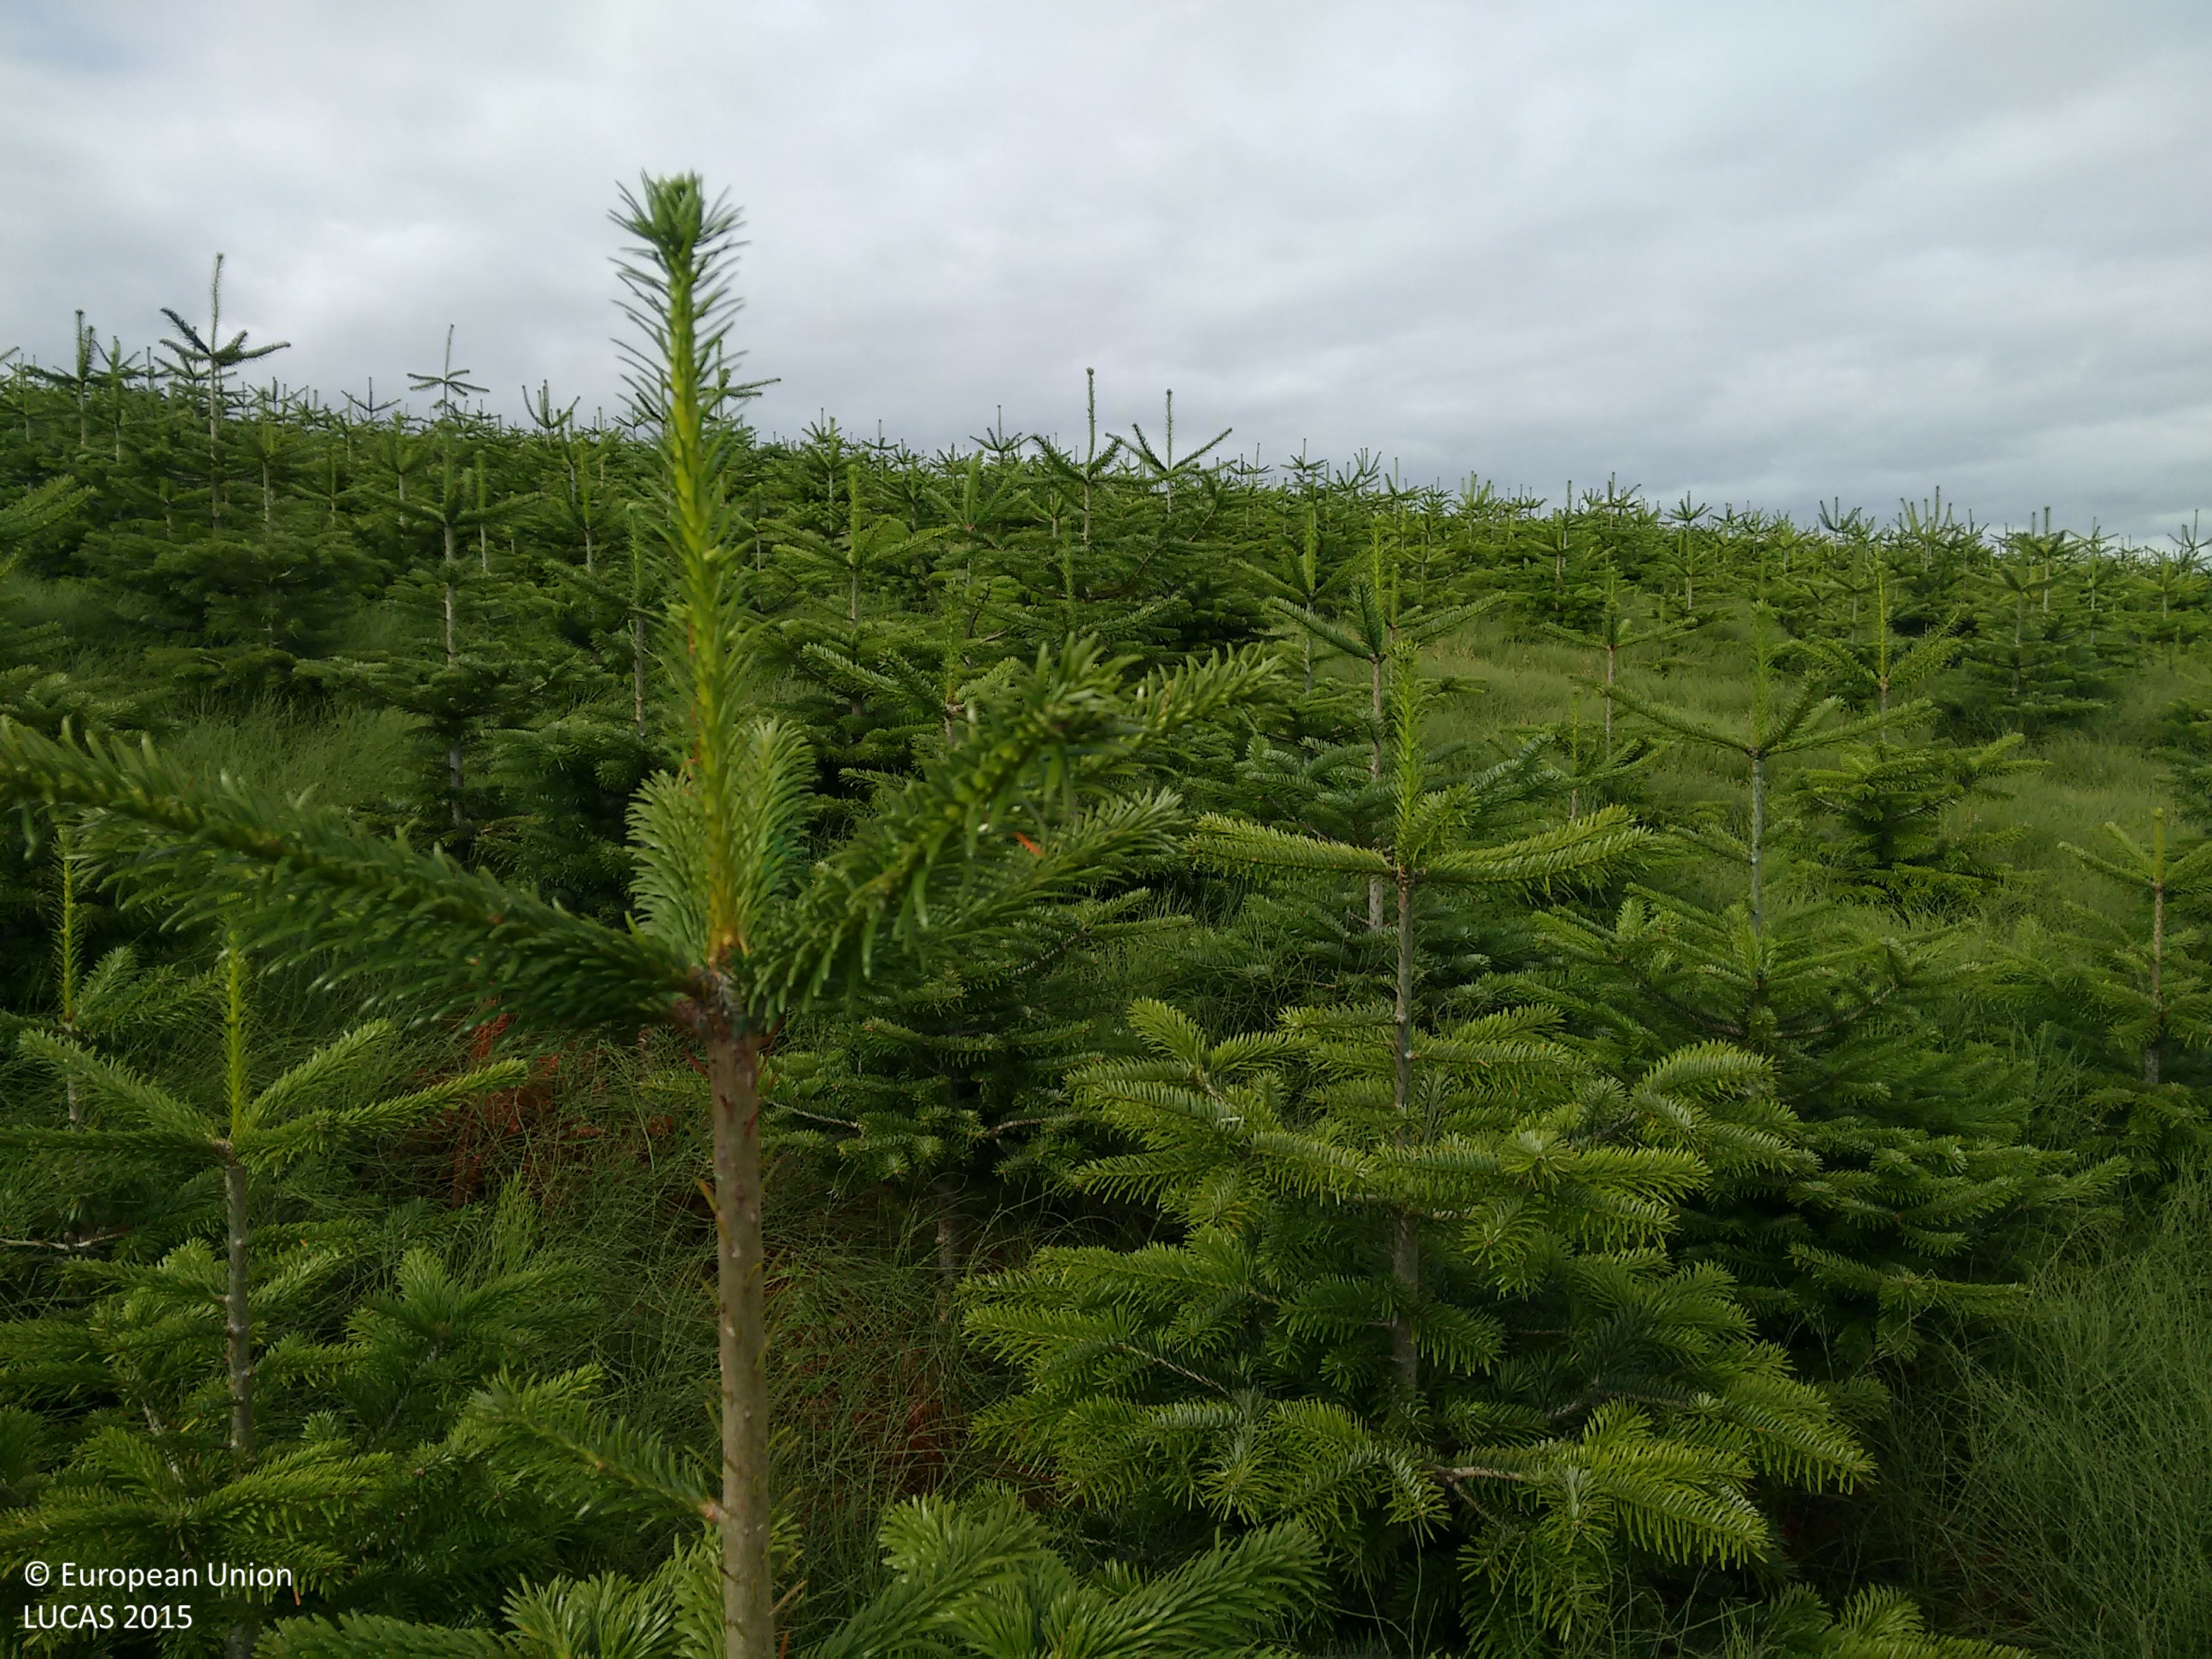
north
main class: Woodland
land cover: Spruce dominated coniferous woodland
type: exotic forest
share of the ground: > 75 %
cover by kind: coniferous forest trees 70 %, herbaceous plants 15 %, unconsolidated bare surface 15 %
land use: Forestry
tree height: < 5 m
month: August
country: GB
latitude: 57.5299
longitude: -4.2306
